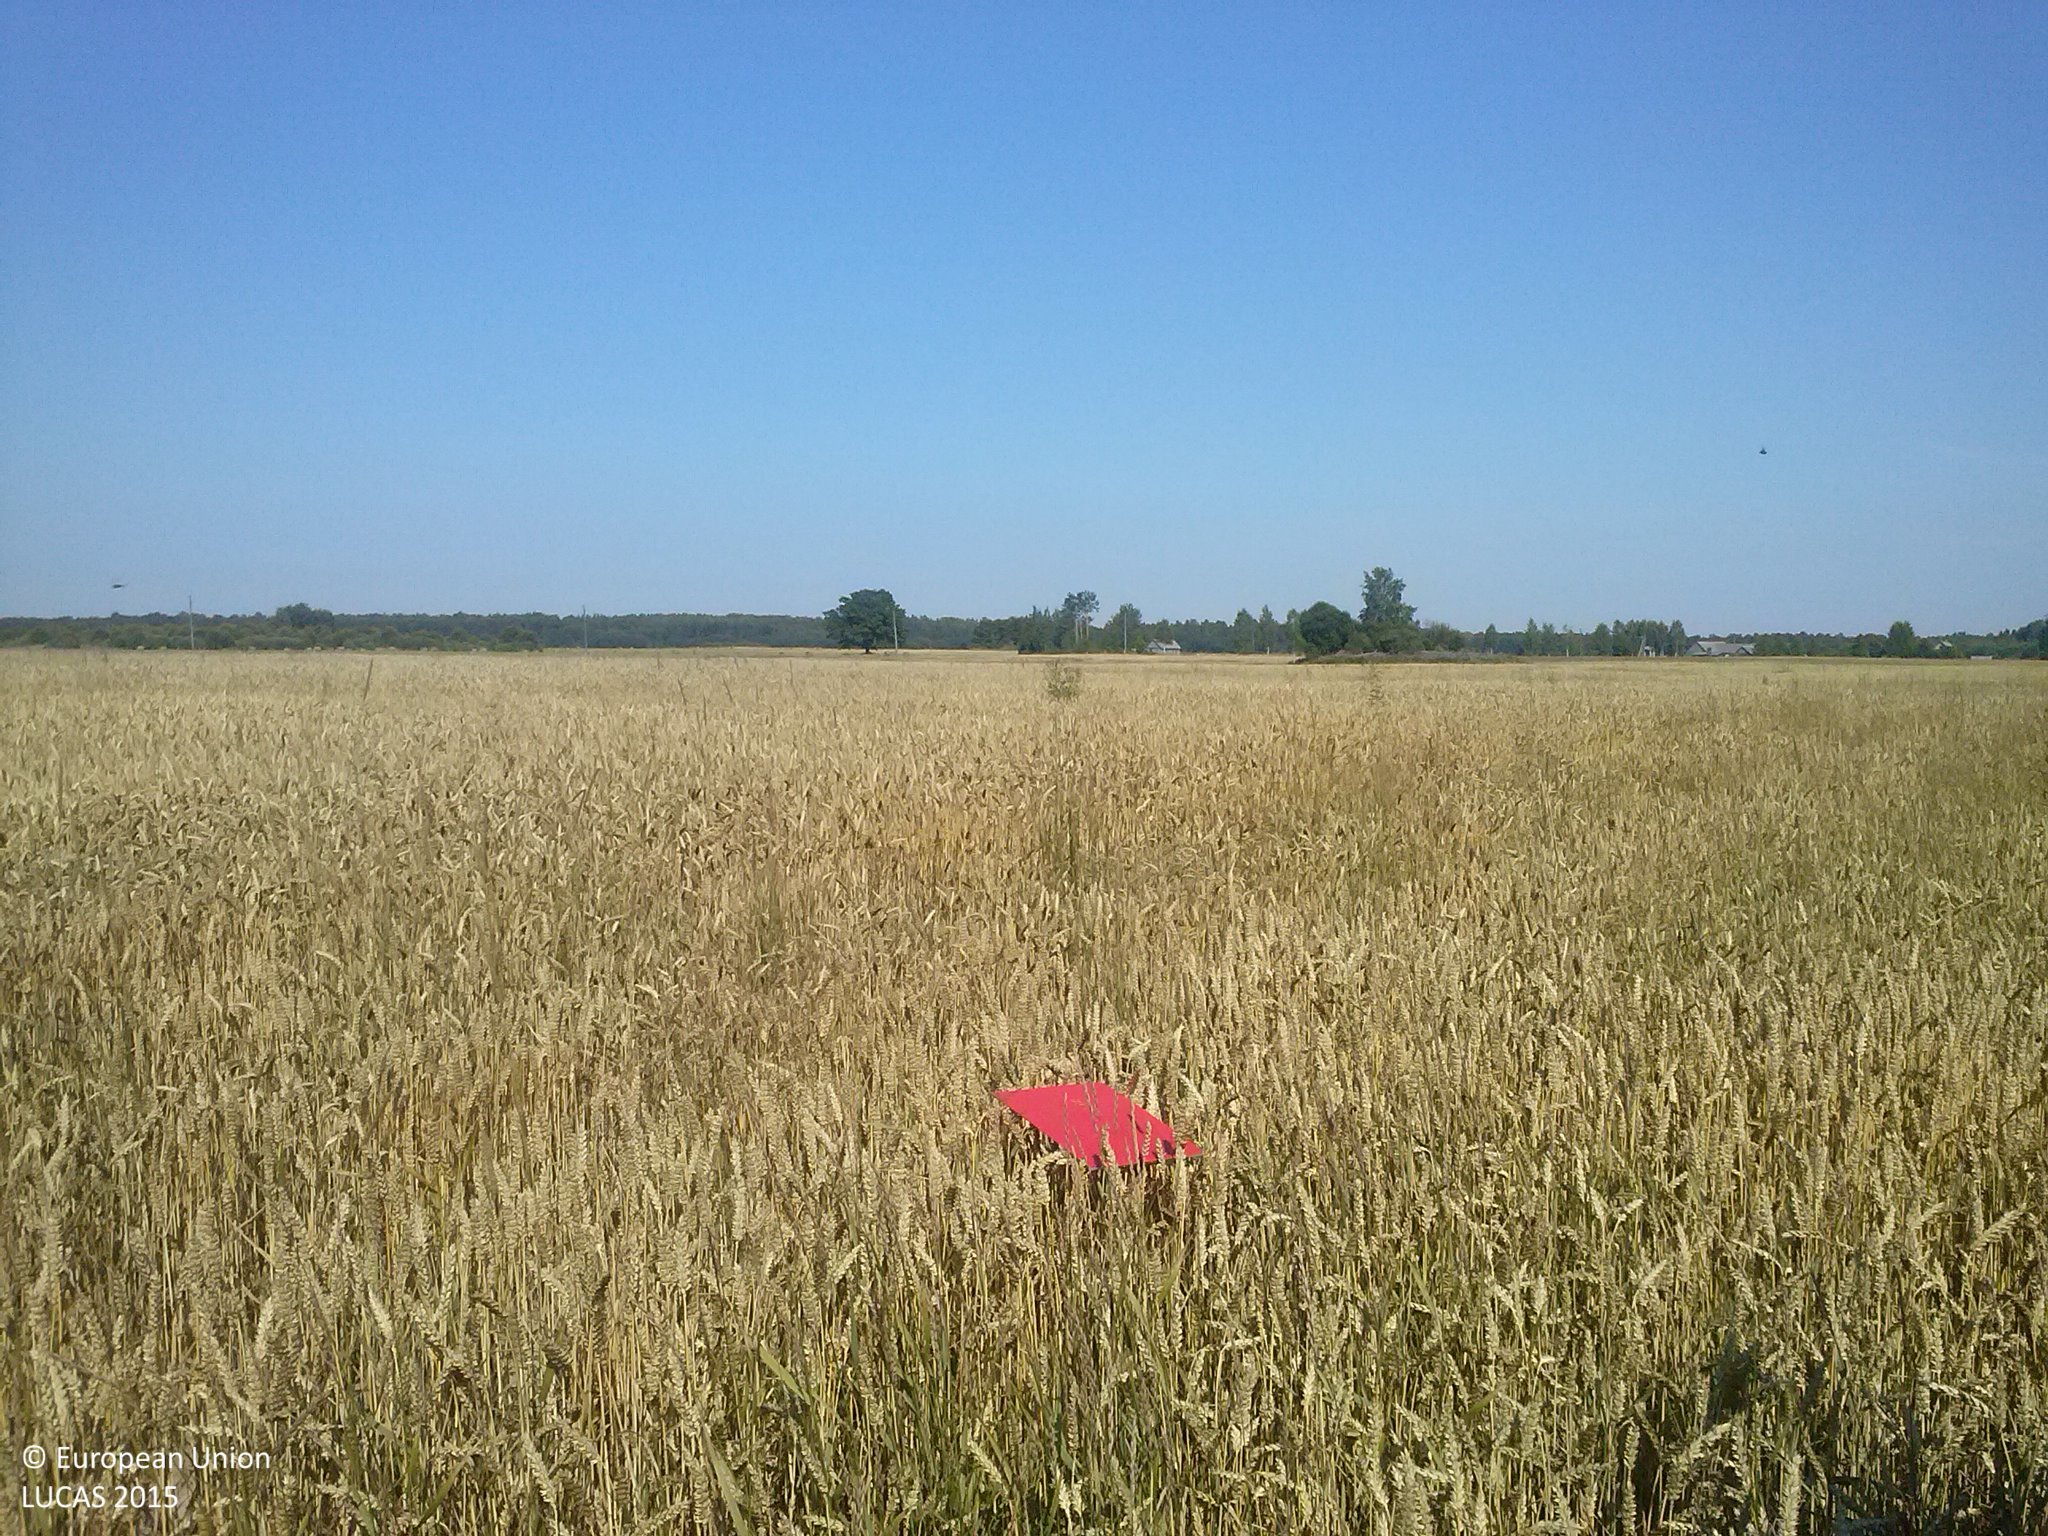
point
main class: Cropland
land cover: Common wheat
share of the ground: > 75 %
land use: Agriculture (excluding fallow land and kitchen gardens)
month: August
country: LV
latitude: 56.6998
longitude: 27.8103
